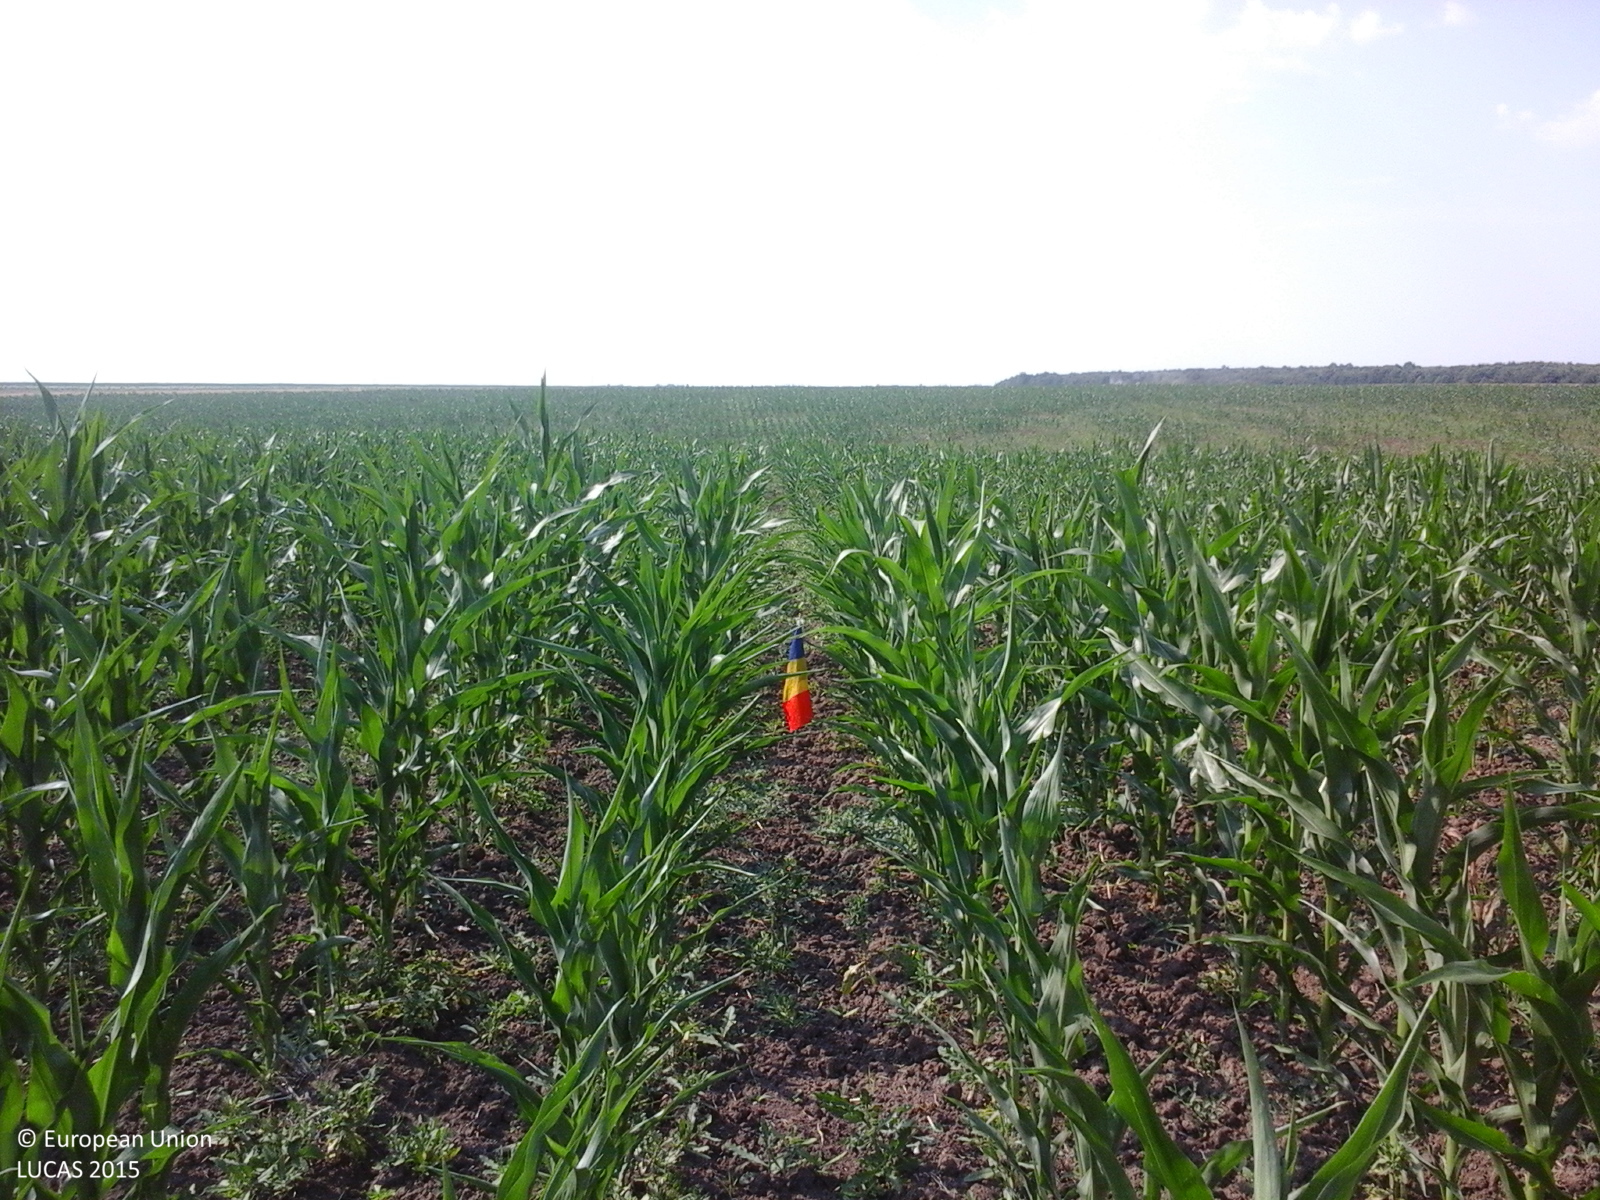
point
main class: Cropland
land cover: Maize
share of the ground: 50 - 75 %
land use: Agriculture (excluding fallow land and kitchen gardens)
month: July
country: RO
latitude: 44.4396
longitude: 25.2762
